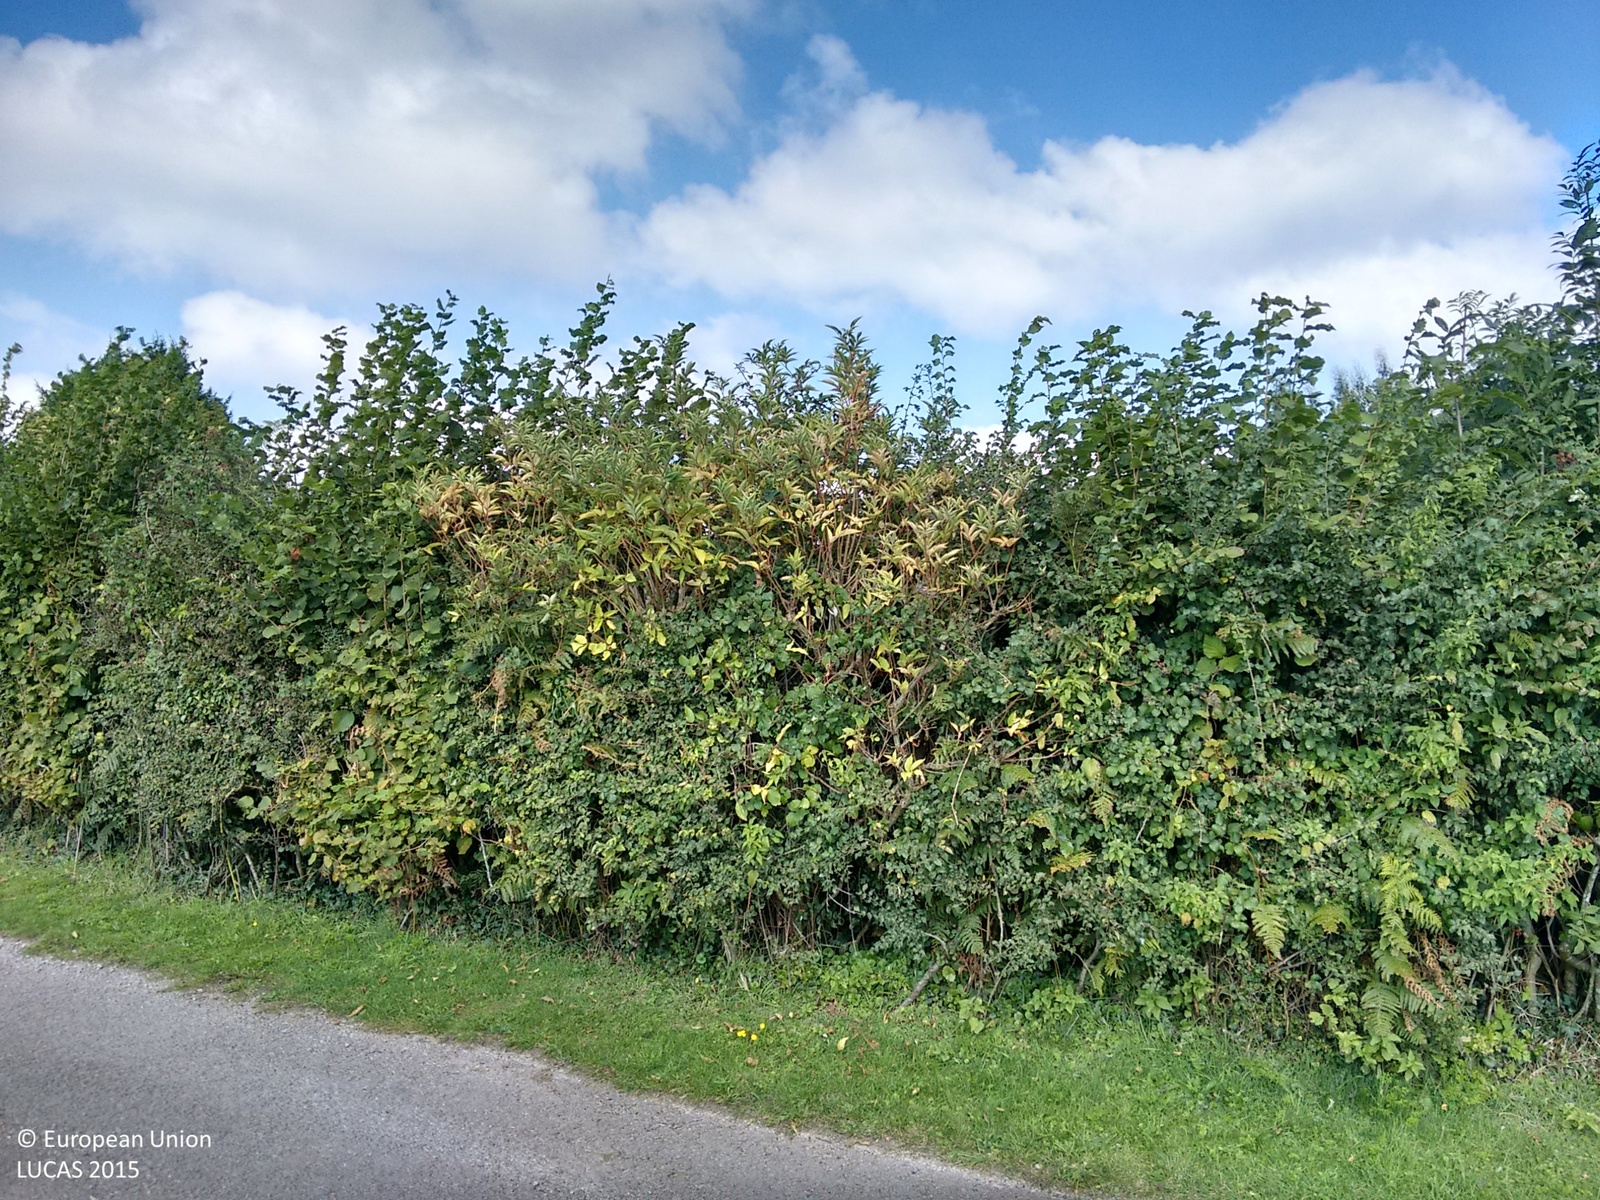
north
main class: Grassland
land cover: Grassland without tree/shrub cover
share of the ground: > 75 %
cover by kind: herbaceous plants 100 %
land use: Agriculture (excluding fallow land and kitchen gardens)
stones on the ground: < 10 %
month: October
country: GB
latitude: 51.7013
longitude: -2.6134
